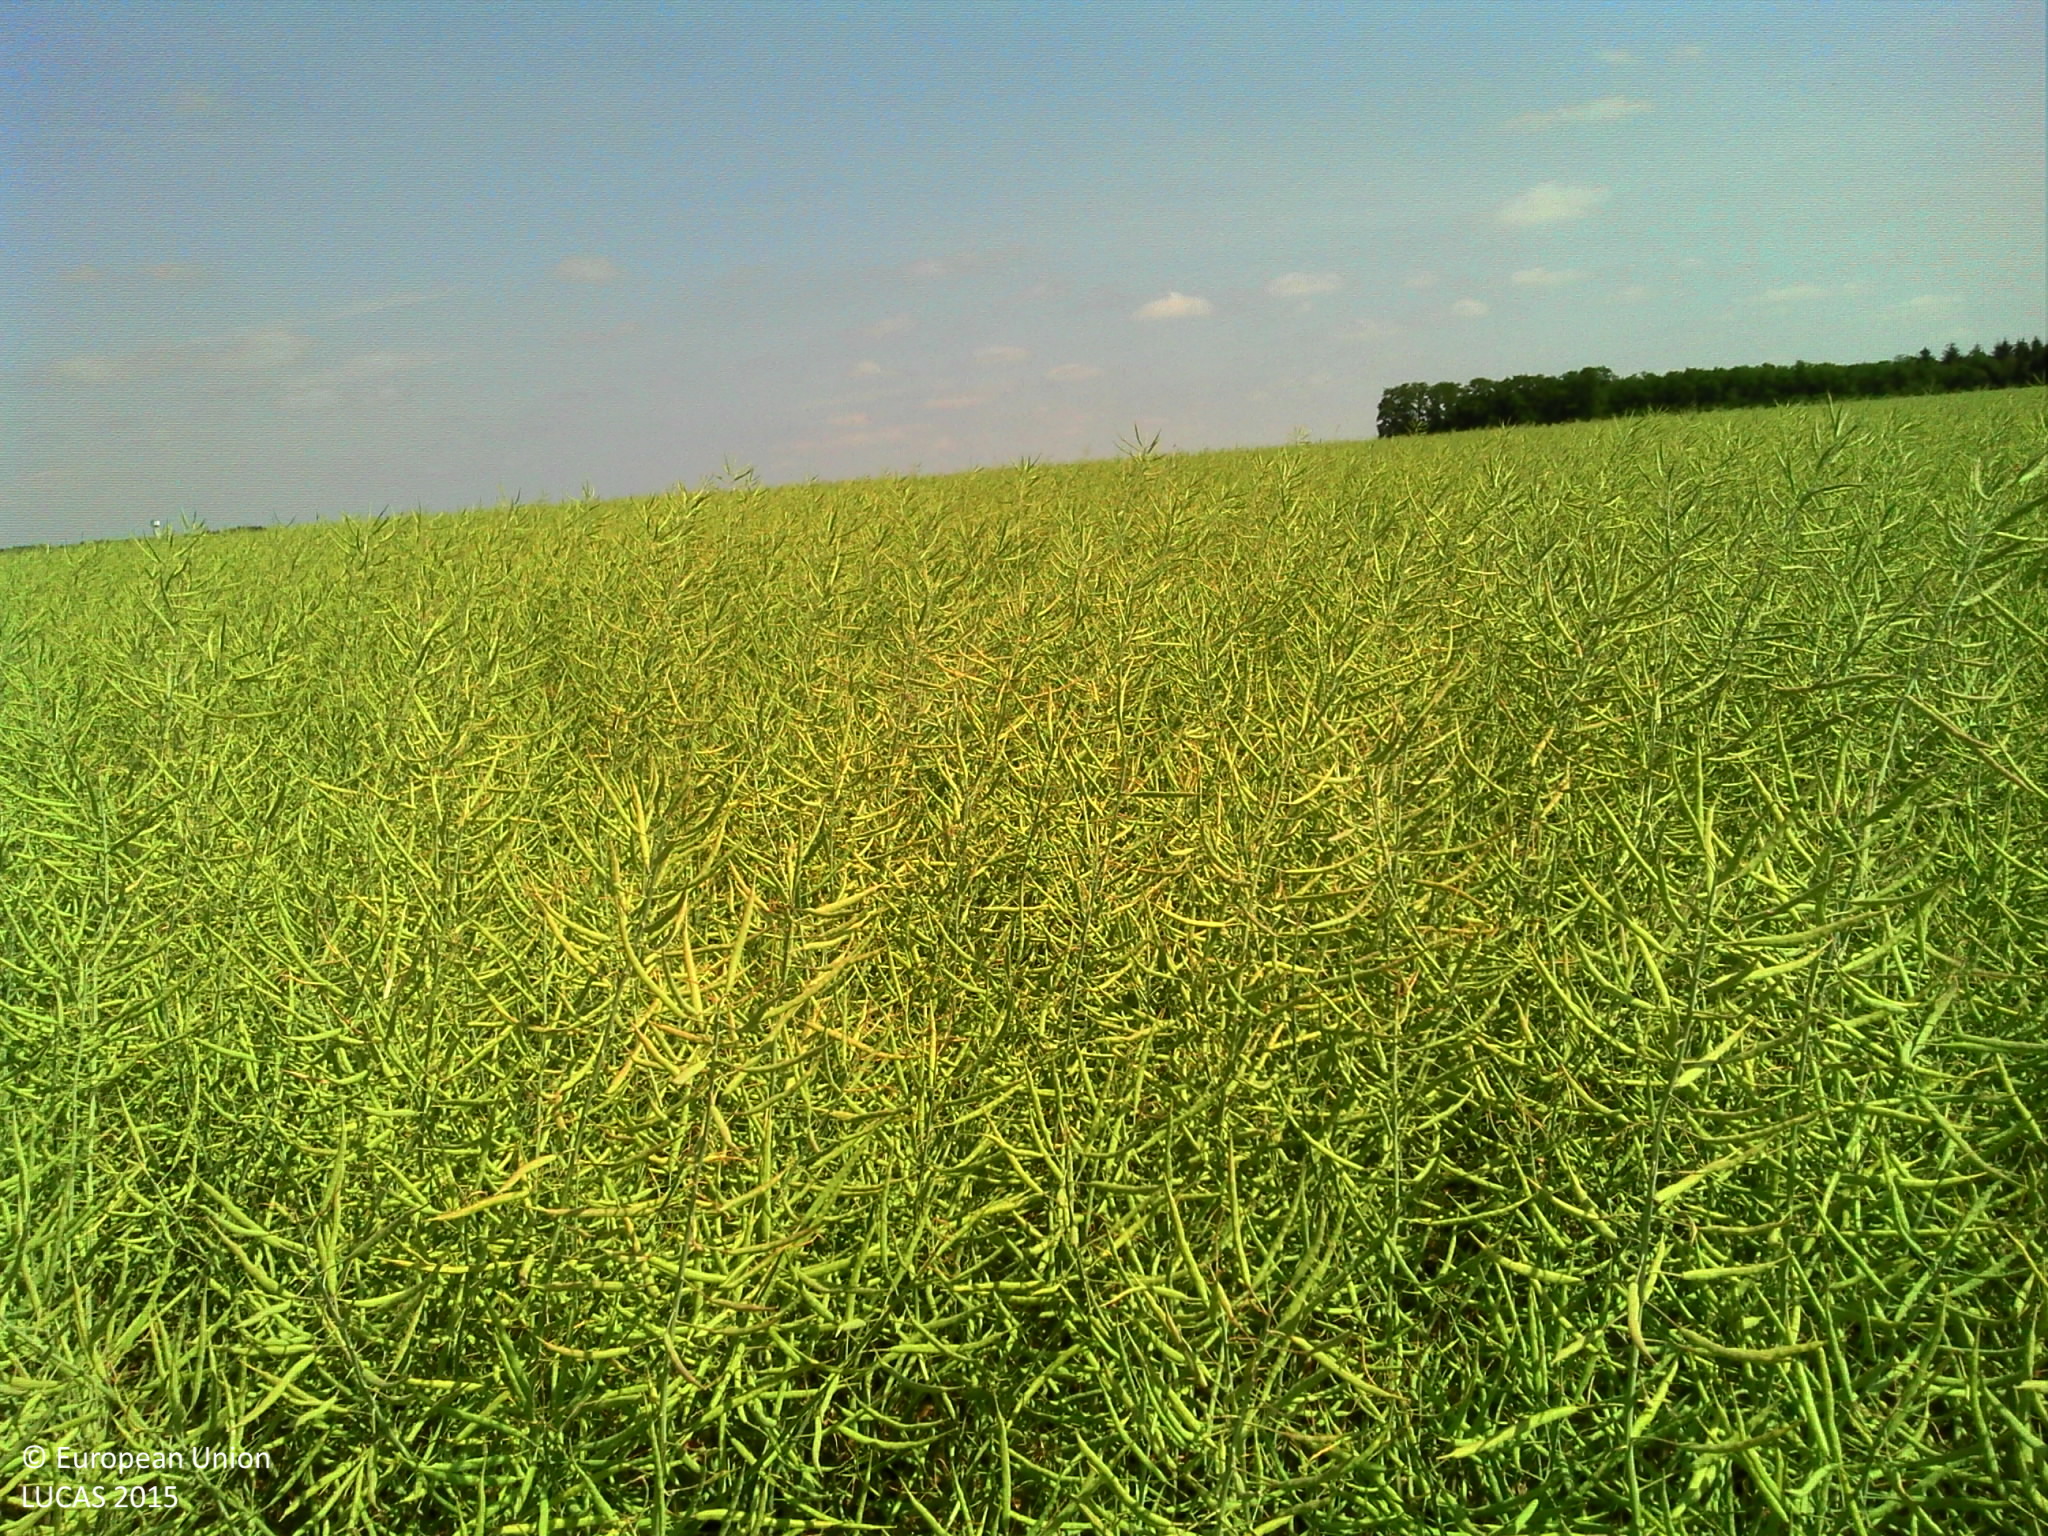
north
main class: Cropland
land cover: Rape and turnip rape
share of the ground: > 75 %
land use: Agriculture (excluding fallow land and kitchen gardens)
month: June
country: FR
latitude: 47.5064
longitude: 5.2075
